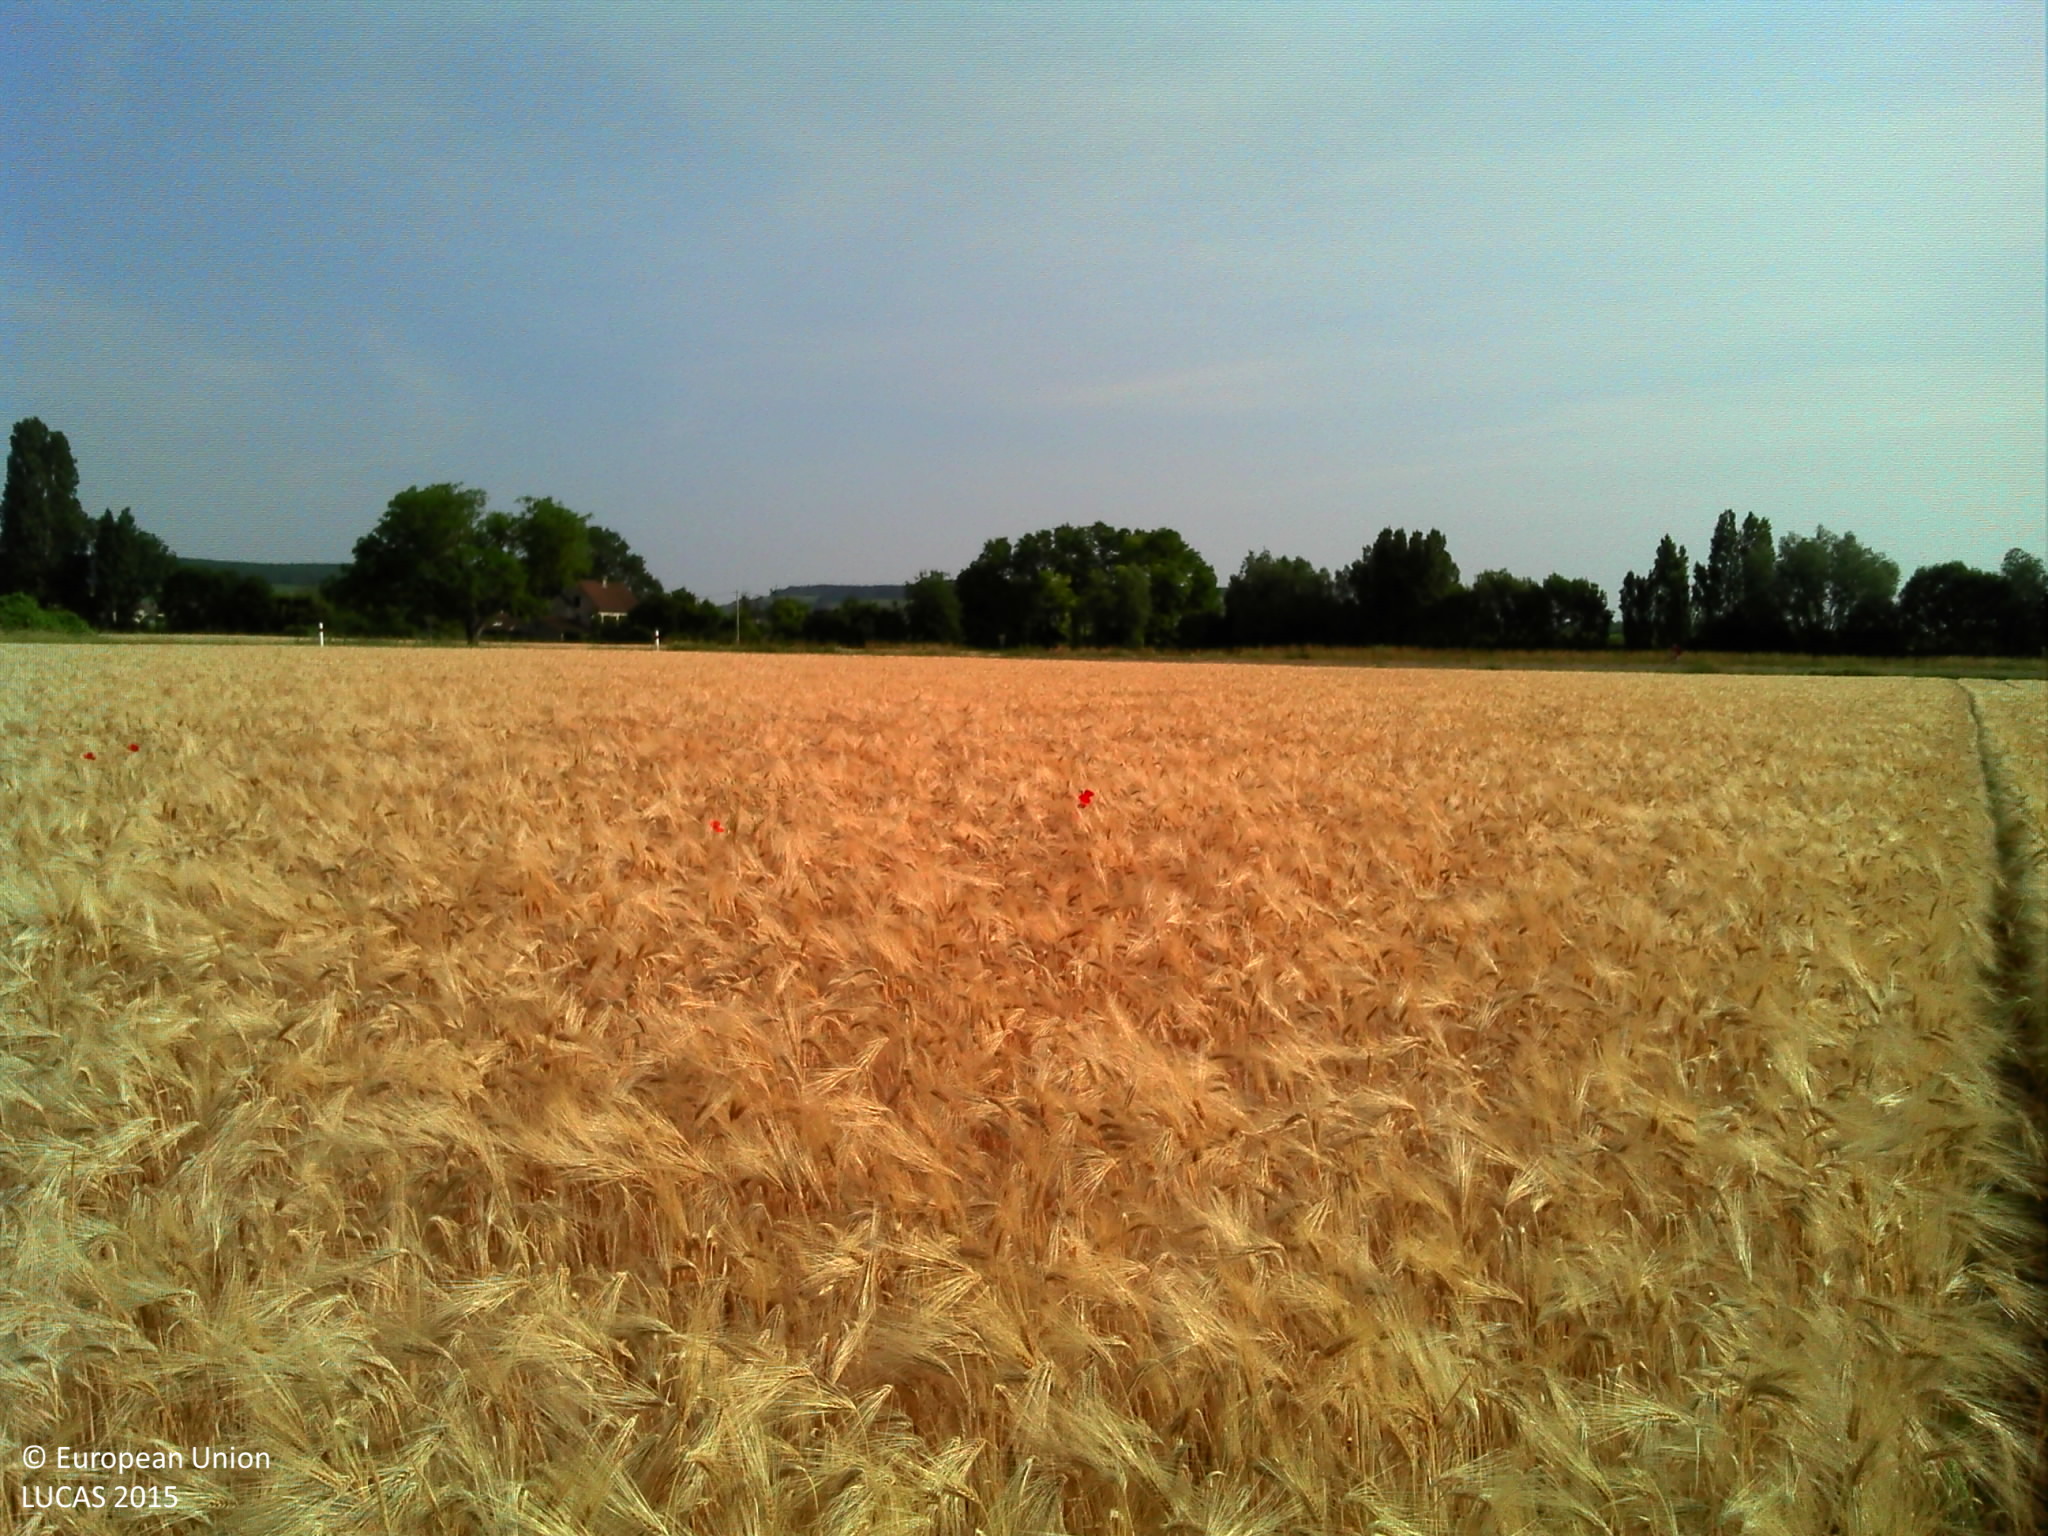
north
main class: Cropland
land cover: Barley
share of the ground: > 75 %
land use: Agriculture (excluding fallow land and kitchen gardens)
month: June
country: FR
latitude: 47.0394
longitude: 4.8549
